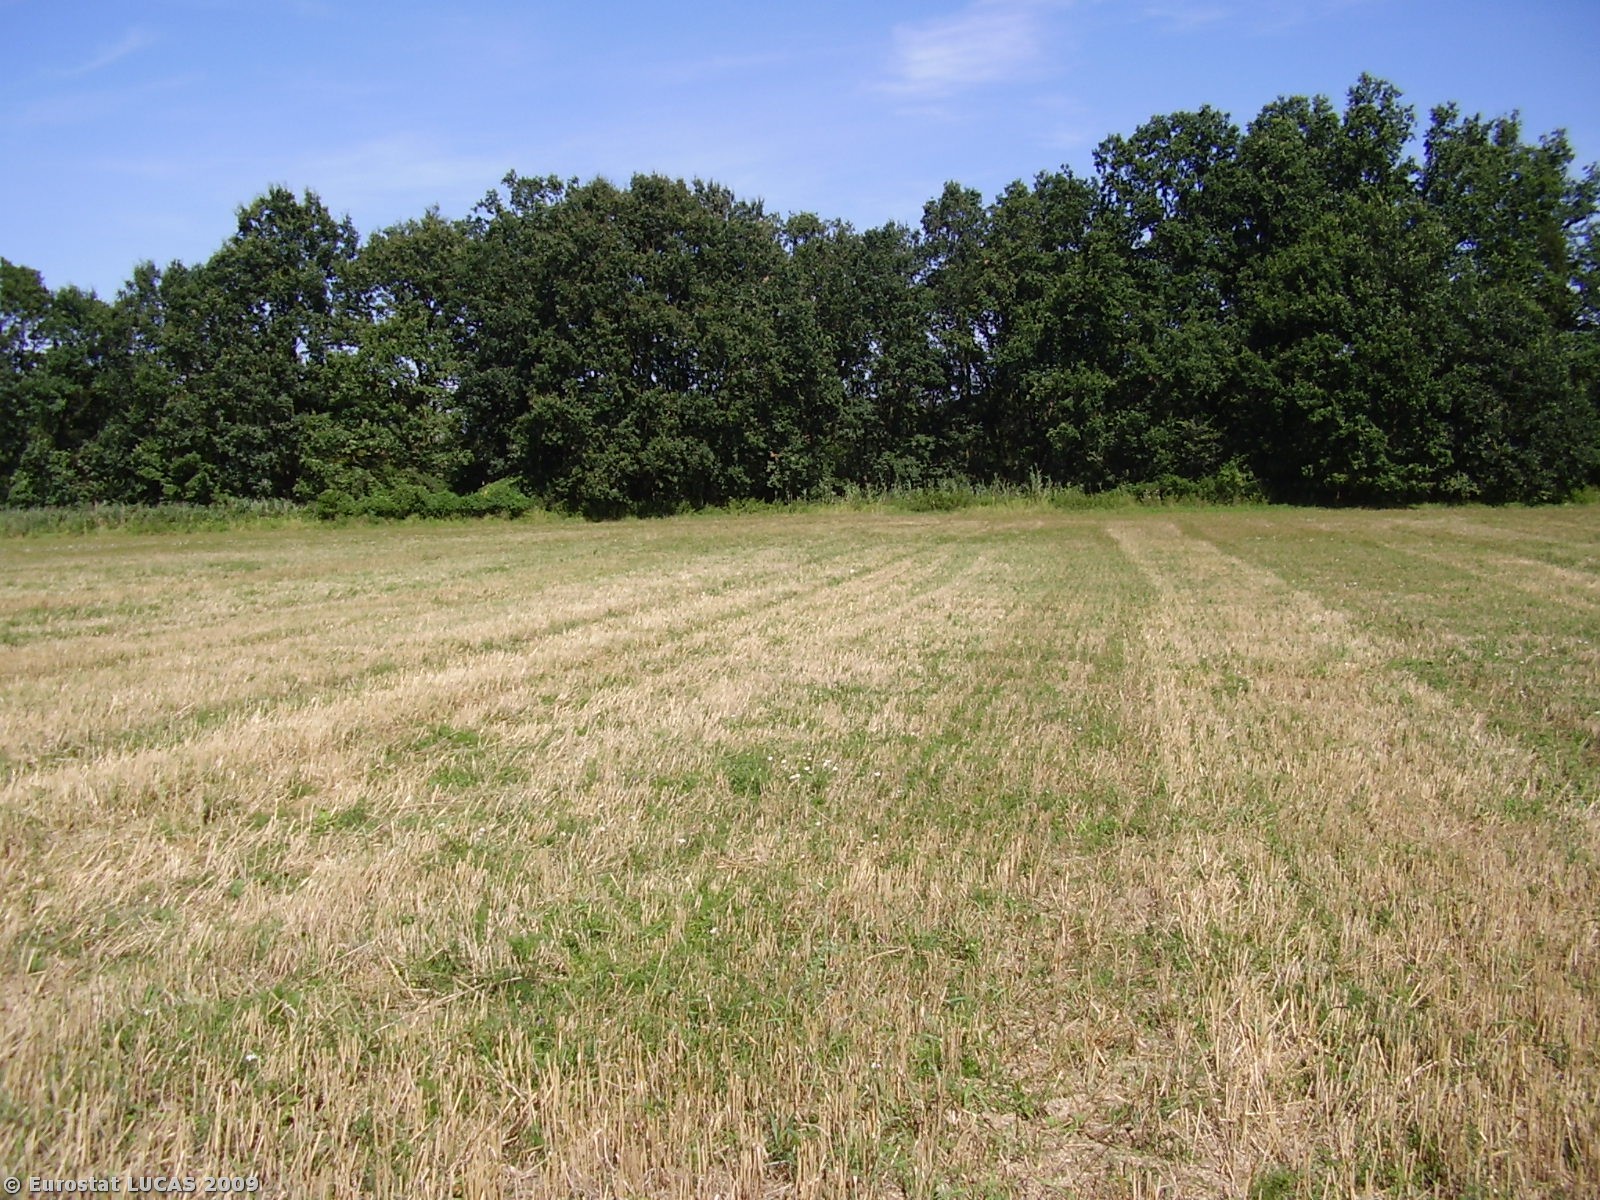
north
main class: Cropland
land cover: Common wheat
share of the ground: < 10 %
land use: Agriculture (excluding fallow land and kitchen gardens)
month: August
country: PL
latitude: 51.4062
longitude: 16.8090
